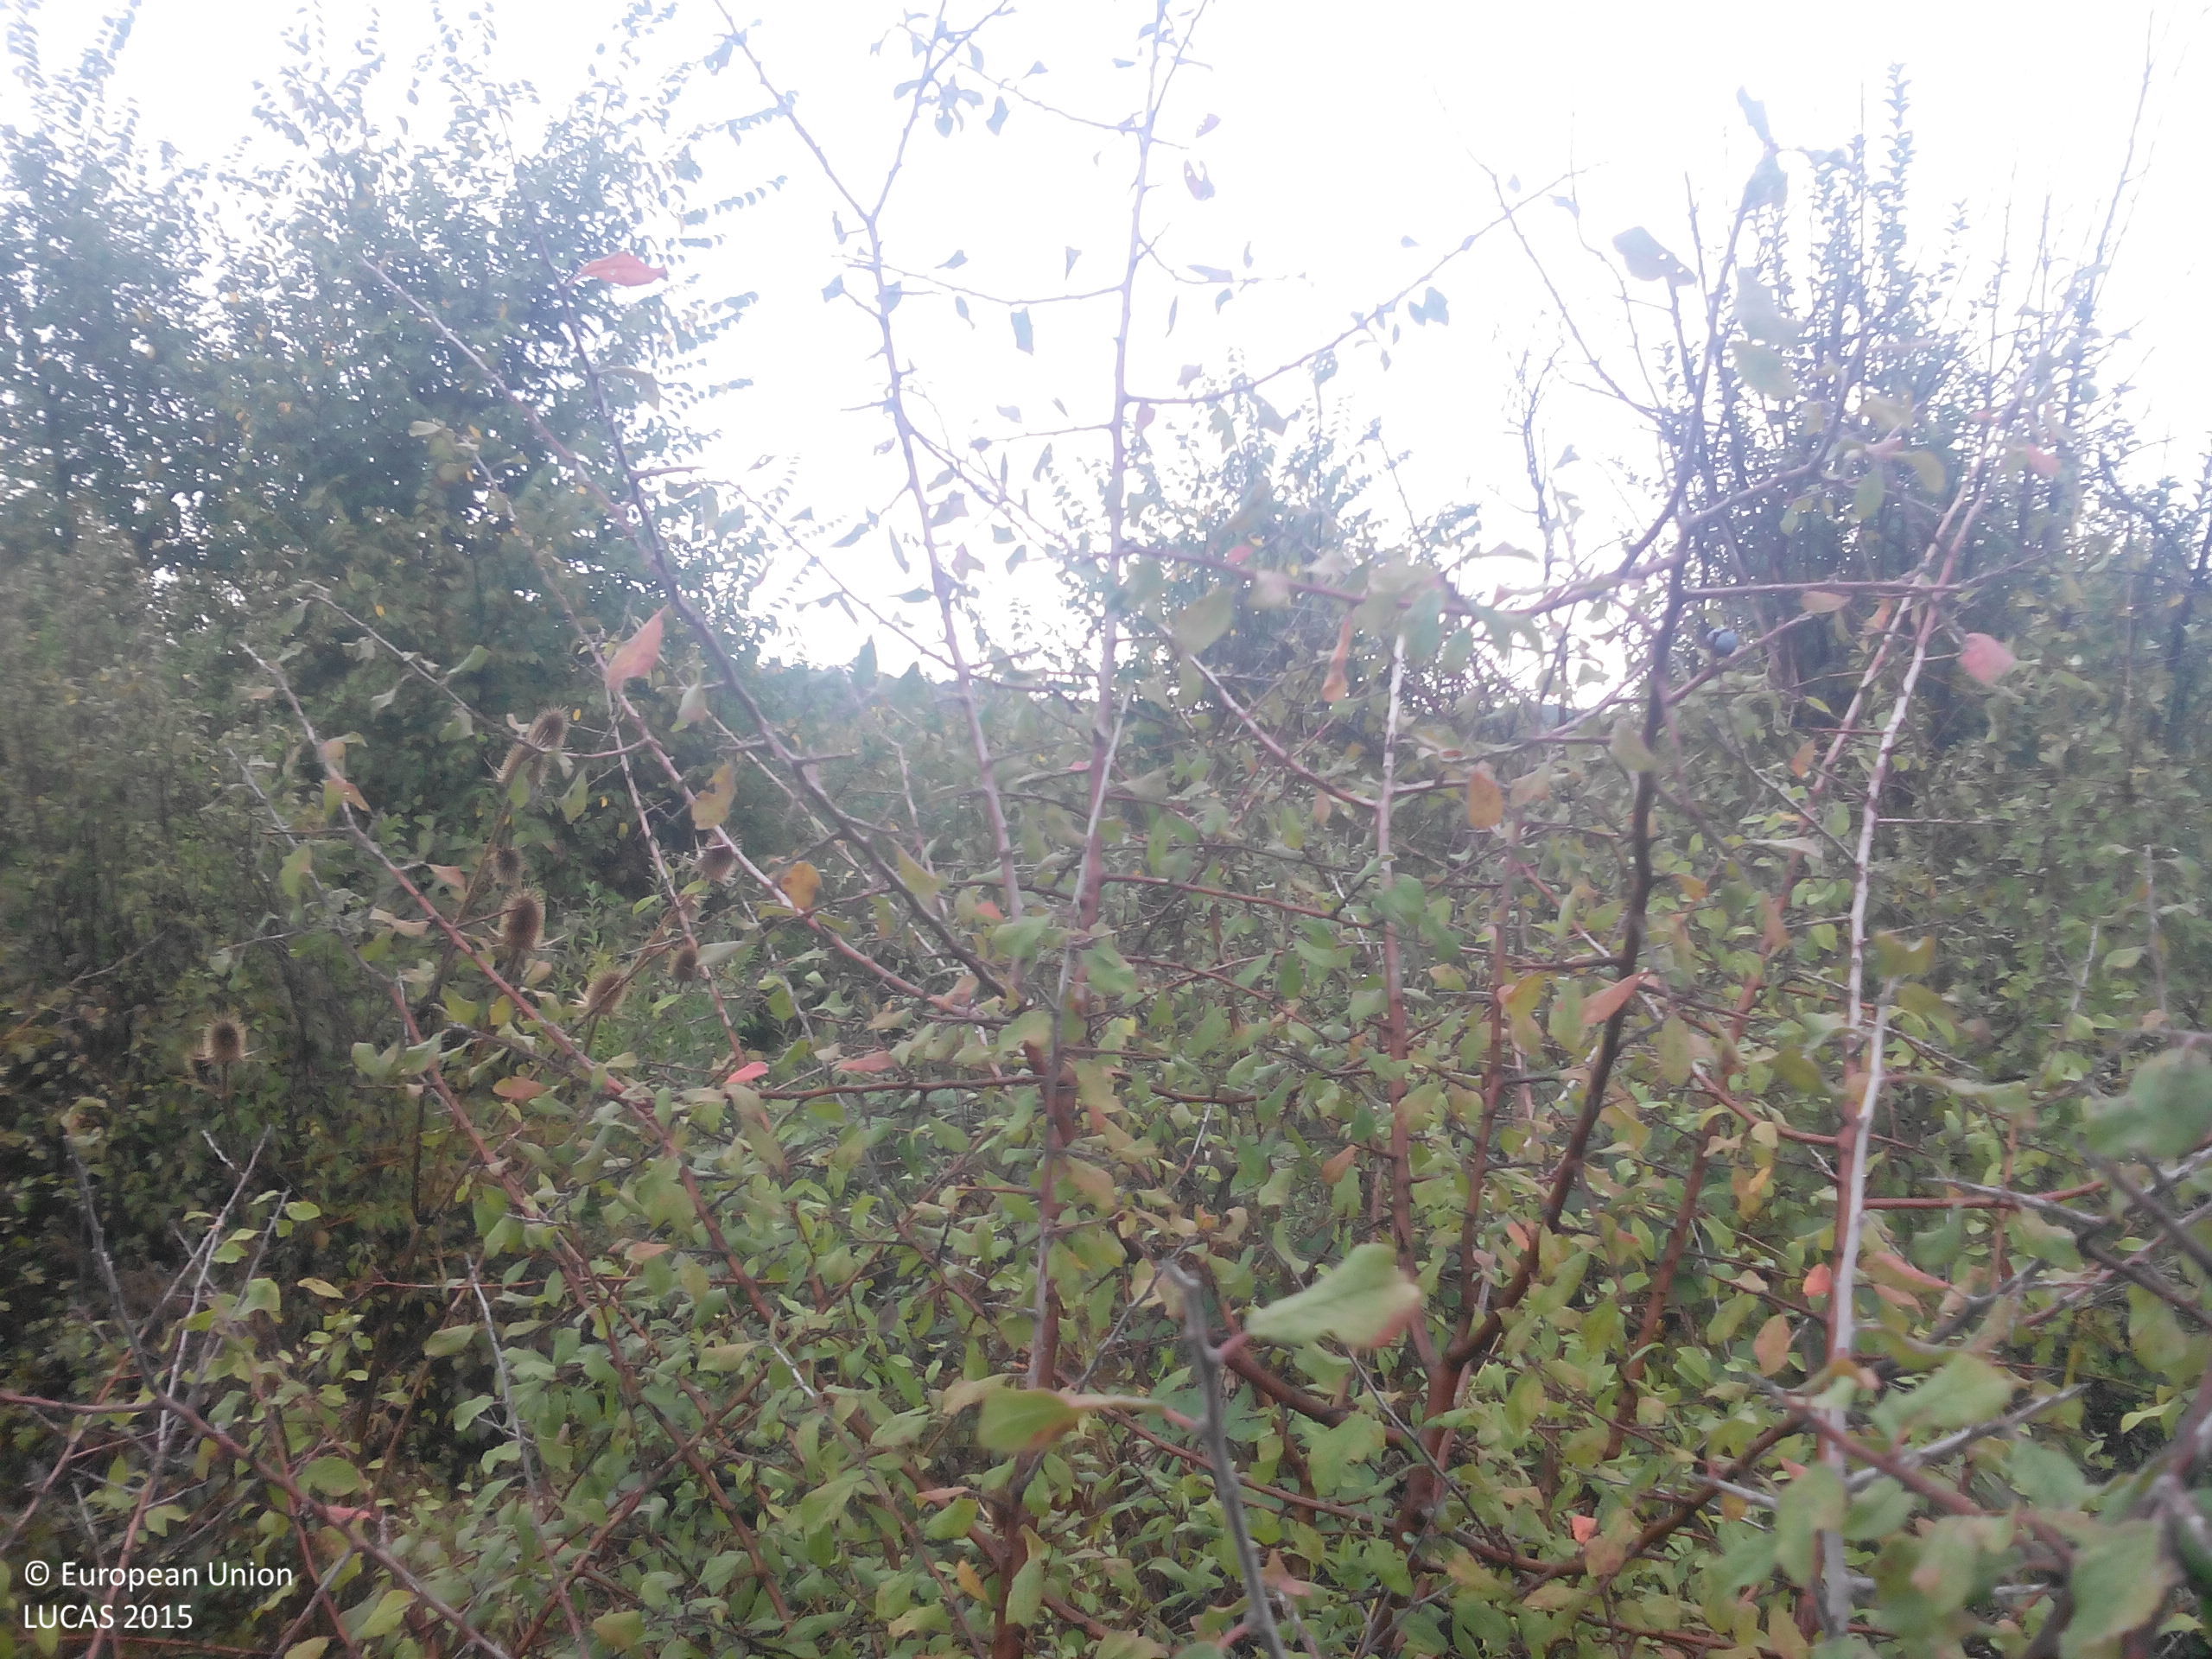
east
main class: Shrubland
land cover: Shrubland with sparse tree cover
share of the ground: > 75 %
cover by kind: shrubs 80 %, herbaceous plants 15 %, broadleaved forest trees 5 %
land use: Abandoned areas
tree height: > 5 m
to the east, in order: Shrubland with sparse tree cover; Other bare soil; Grassland without tree/shrub cover; Maize; Broadleaved woodland; Rivers and streams; Broadleaved woodland; Grassland without tree/shrub cover; Shrubland with sparse tree cover; Grassland without tree/shrub cover; Arable land (only in case pi); Grassland without tree/shrub cover; Tracks; Shrubland with sparse tree cover
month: October
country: BG
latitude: 43.1867
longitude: 24.1903
